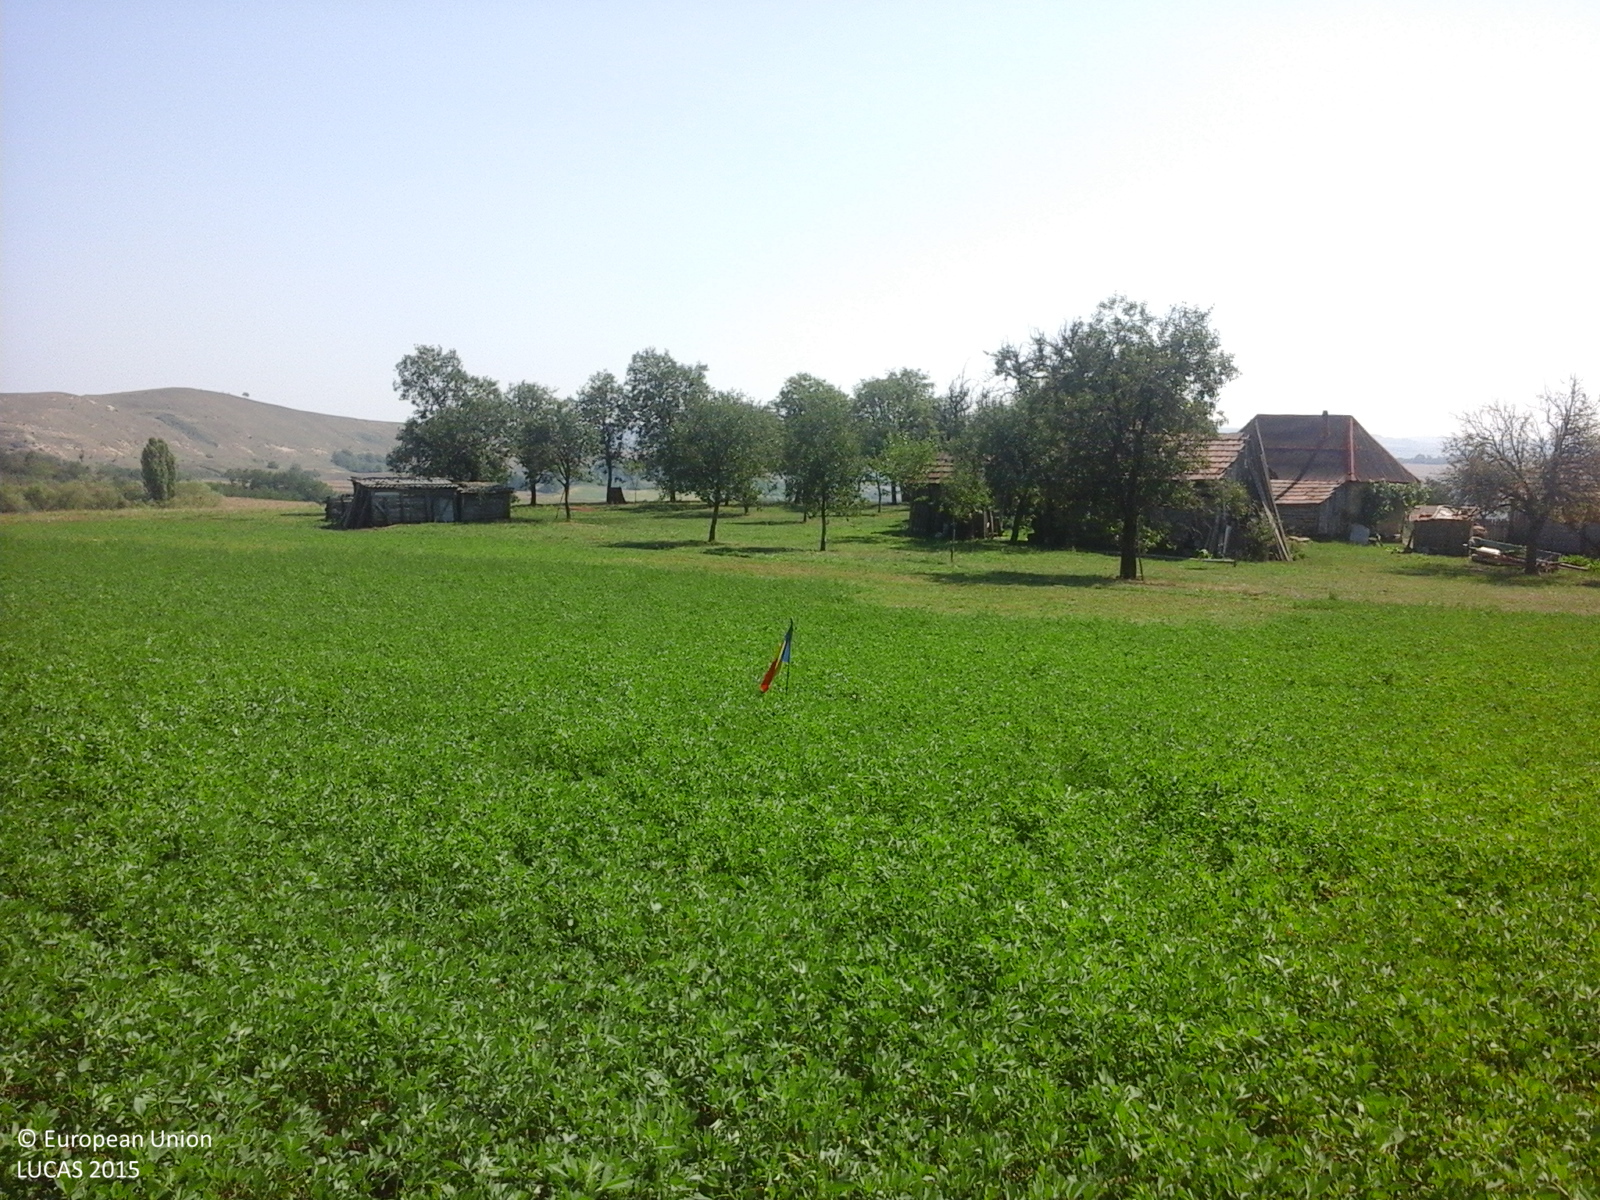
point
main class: Cropland
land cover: Lucerne
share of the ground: > 75 %
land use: Agriculture (excluding fallow land and kitchen gardens)
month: September
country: RO
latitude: 46.7815
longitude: 24.3760
